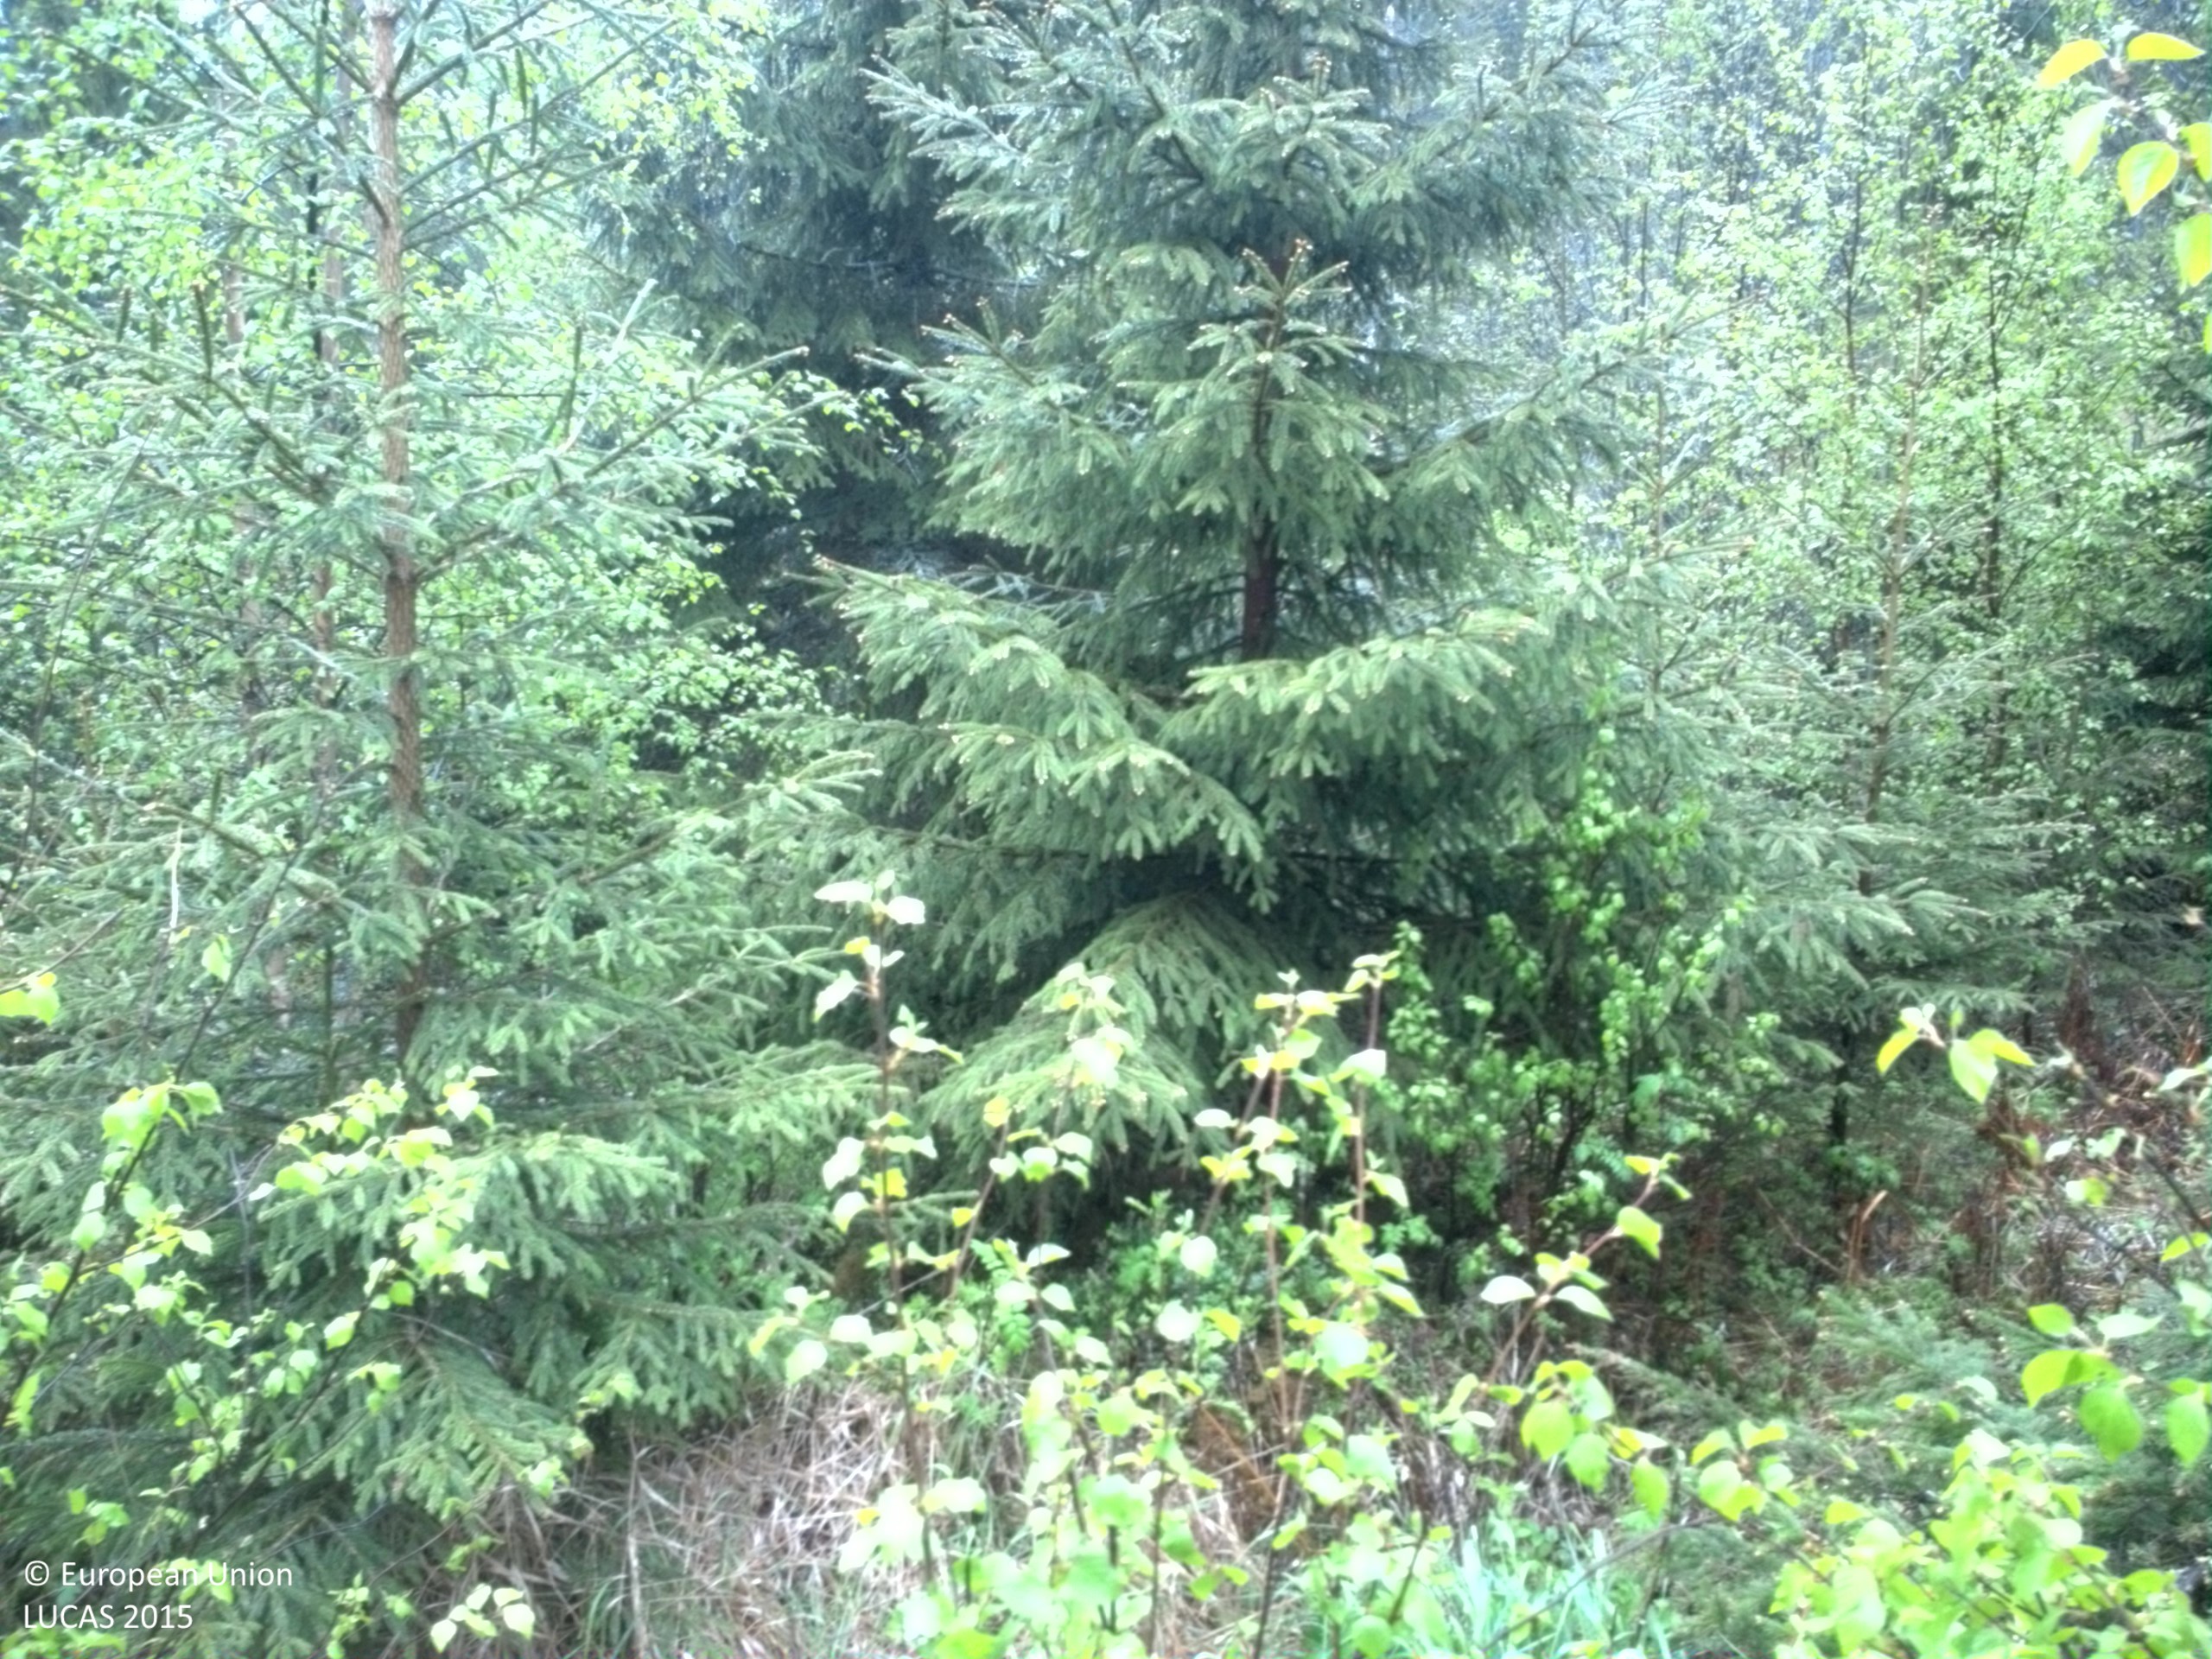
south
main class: Woodland
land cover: Spruce dominated mixed woodland
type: boreal forest
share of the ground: 50 - 75 %
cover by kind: coniferous forest trees 45 %, herbaceous plants 30 %, broadleaved forest trees 15 %, shrubs 10 %
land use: Forestry
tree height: < 5 m
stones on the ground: 25 - 50 %
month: May
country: SE
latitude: 63.0672
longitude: 17.7146
